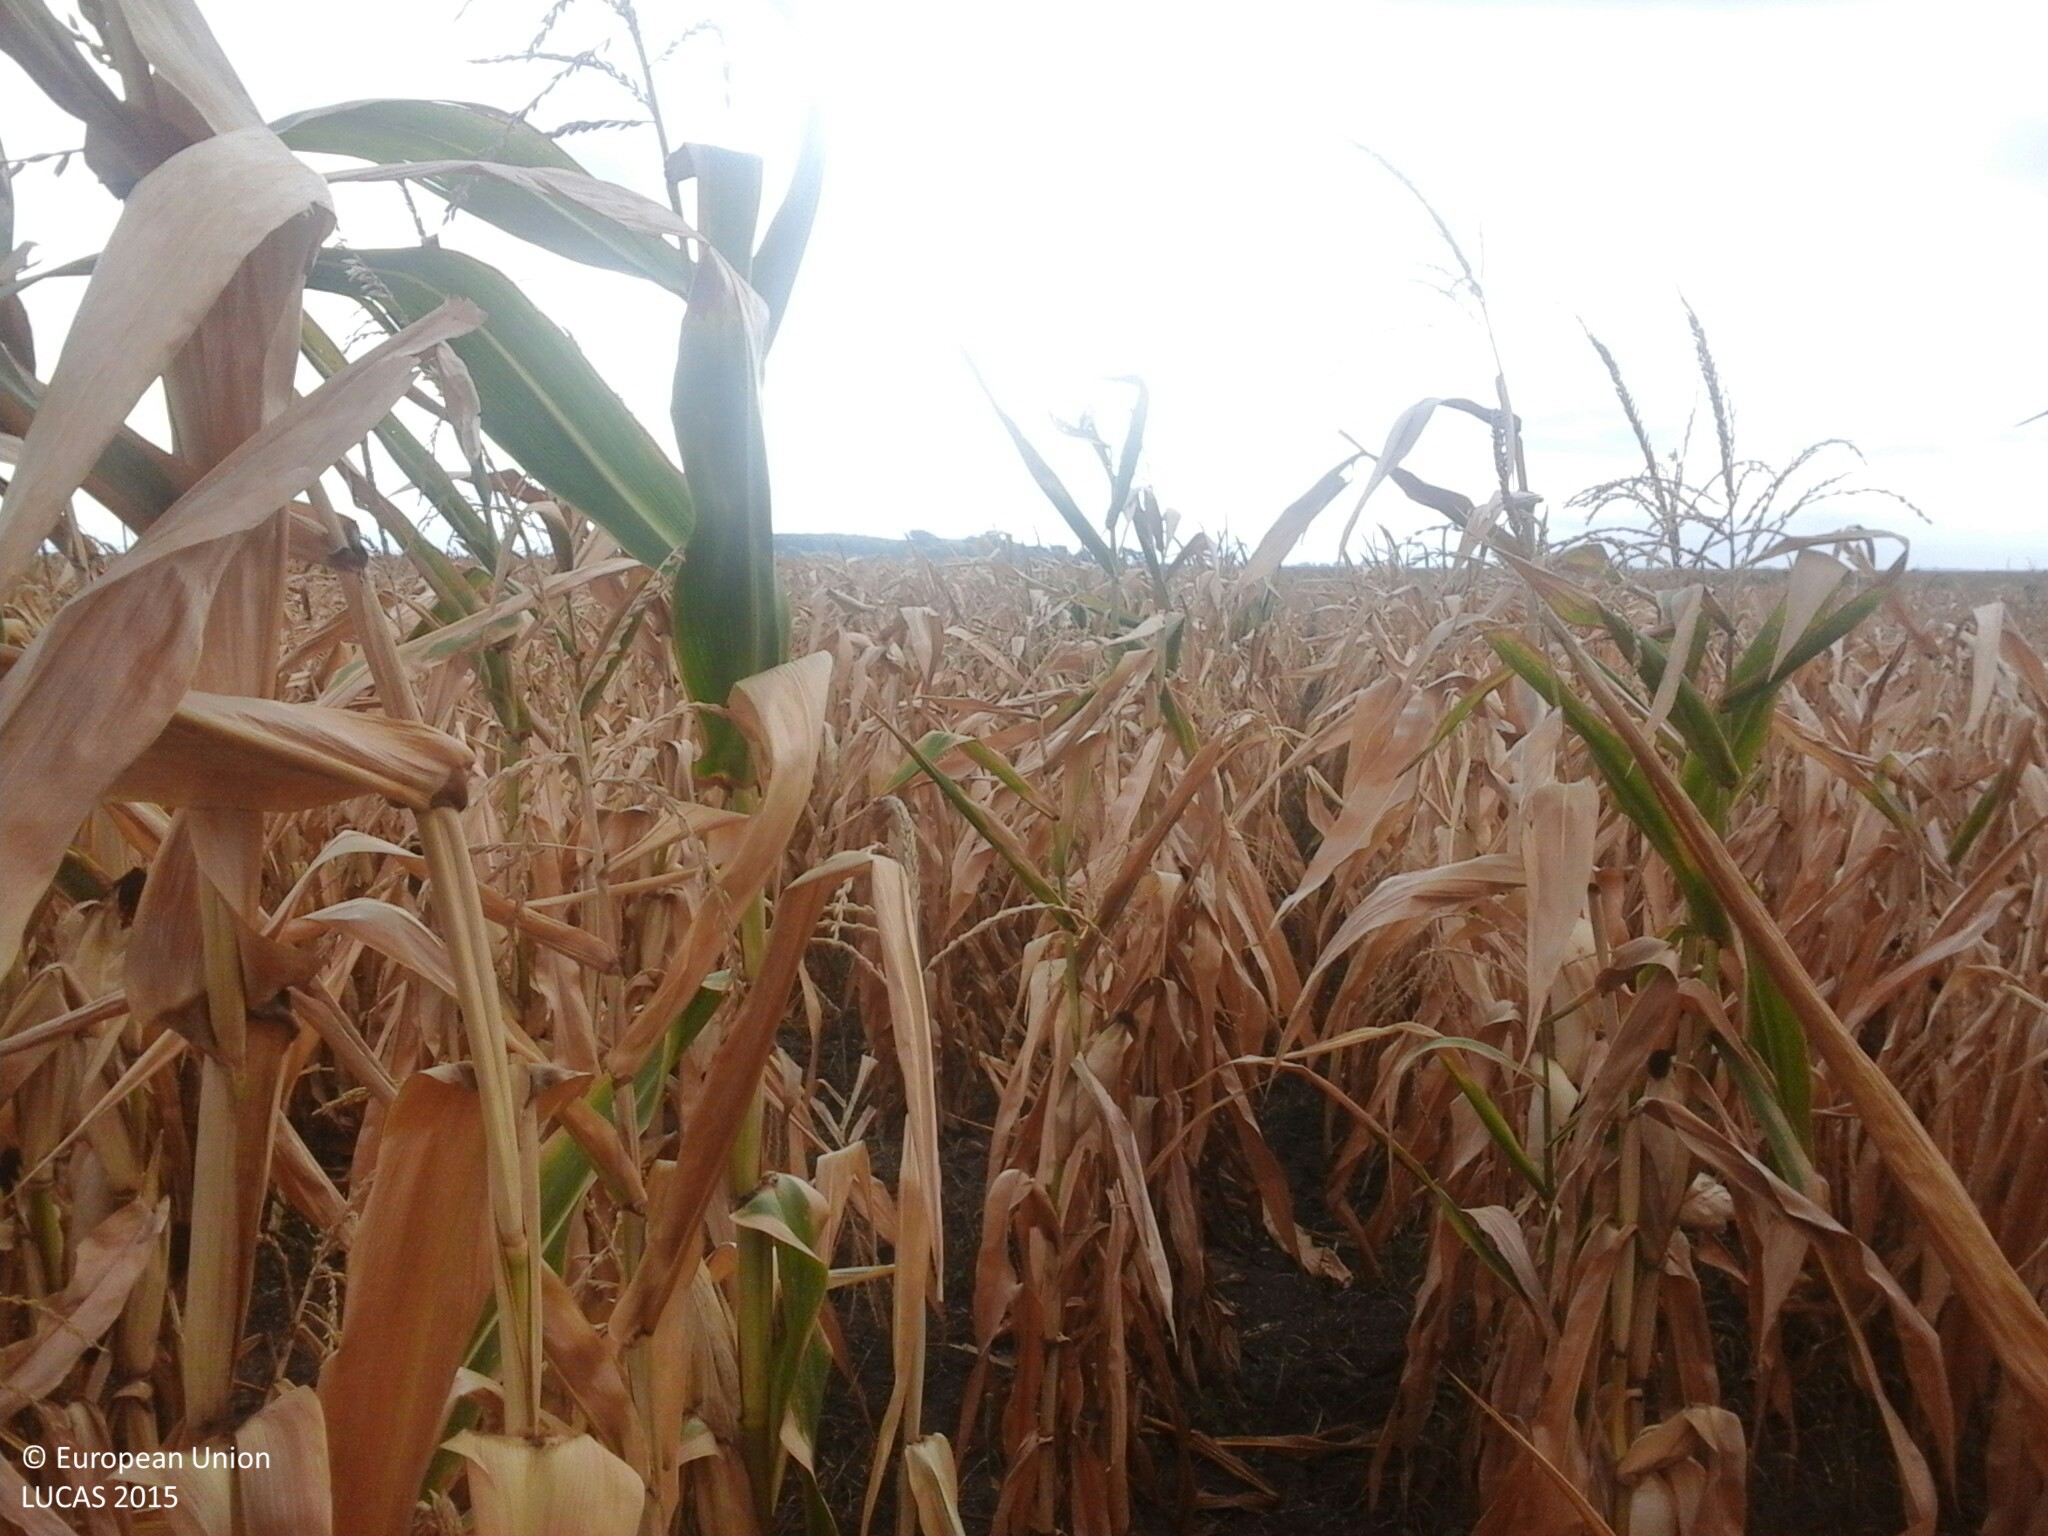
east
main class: Cropland
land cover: Maize
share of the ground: > 75 %
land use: Agriculture (excluding fallow land and kitchen gardens)
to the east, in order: Maize; Grass margins; Other bare soil
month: August
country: HU
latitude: 47.0497
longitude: 21.5593
